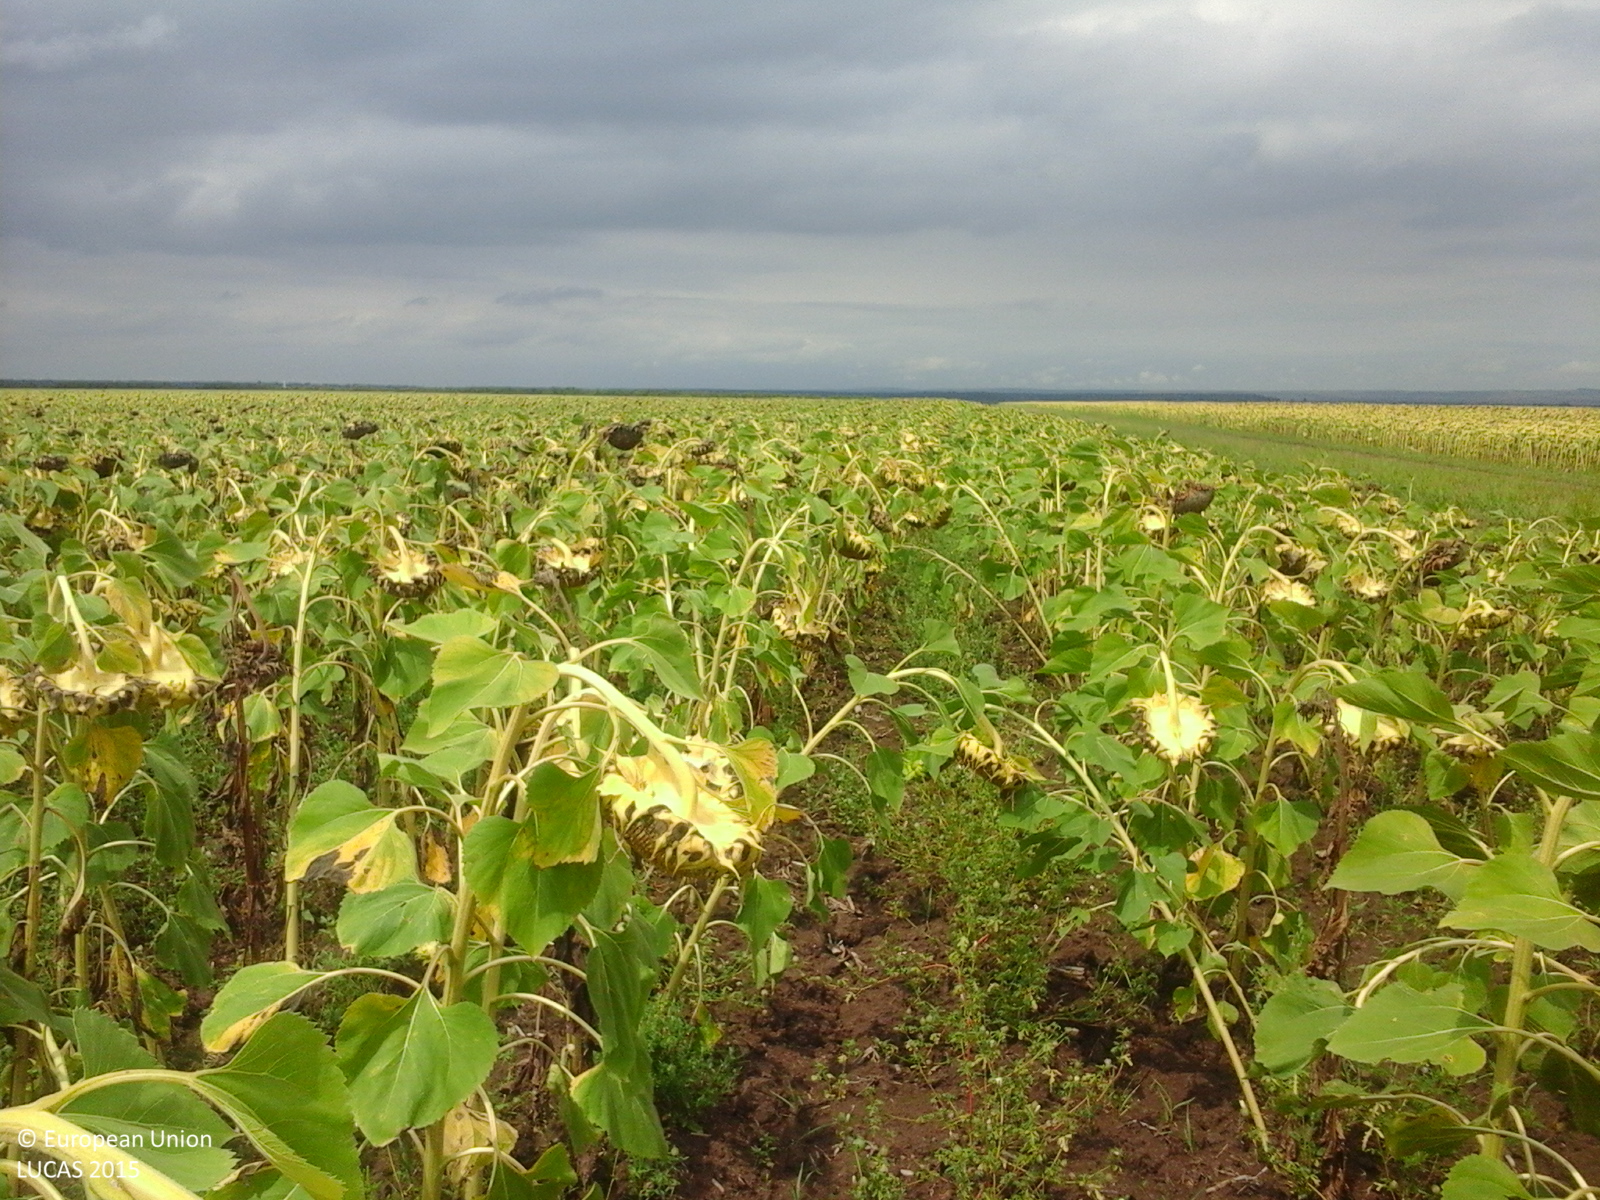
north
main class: Cropland
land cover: Sunflower
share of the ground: > 75 %
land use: Agriculture (excluding fallow land and kitchen gardens)
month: August
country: RO
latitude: 45.6839
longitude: 21.5770
